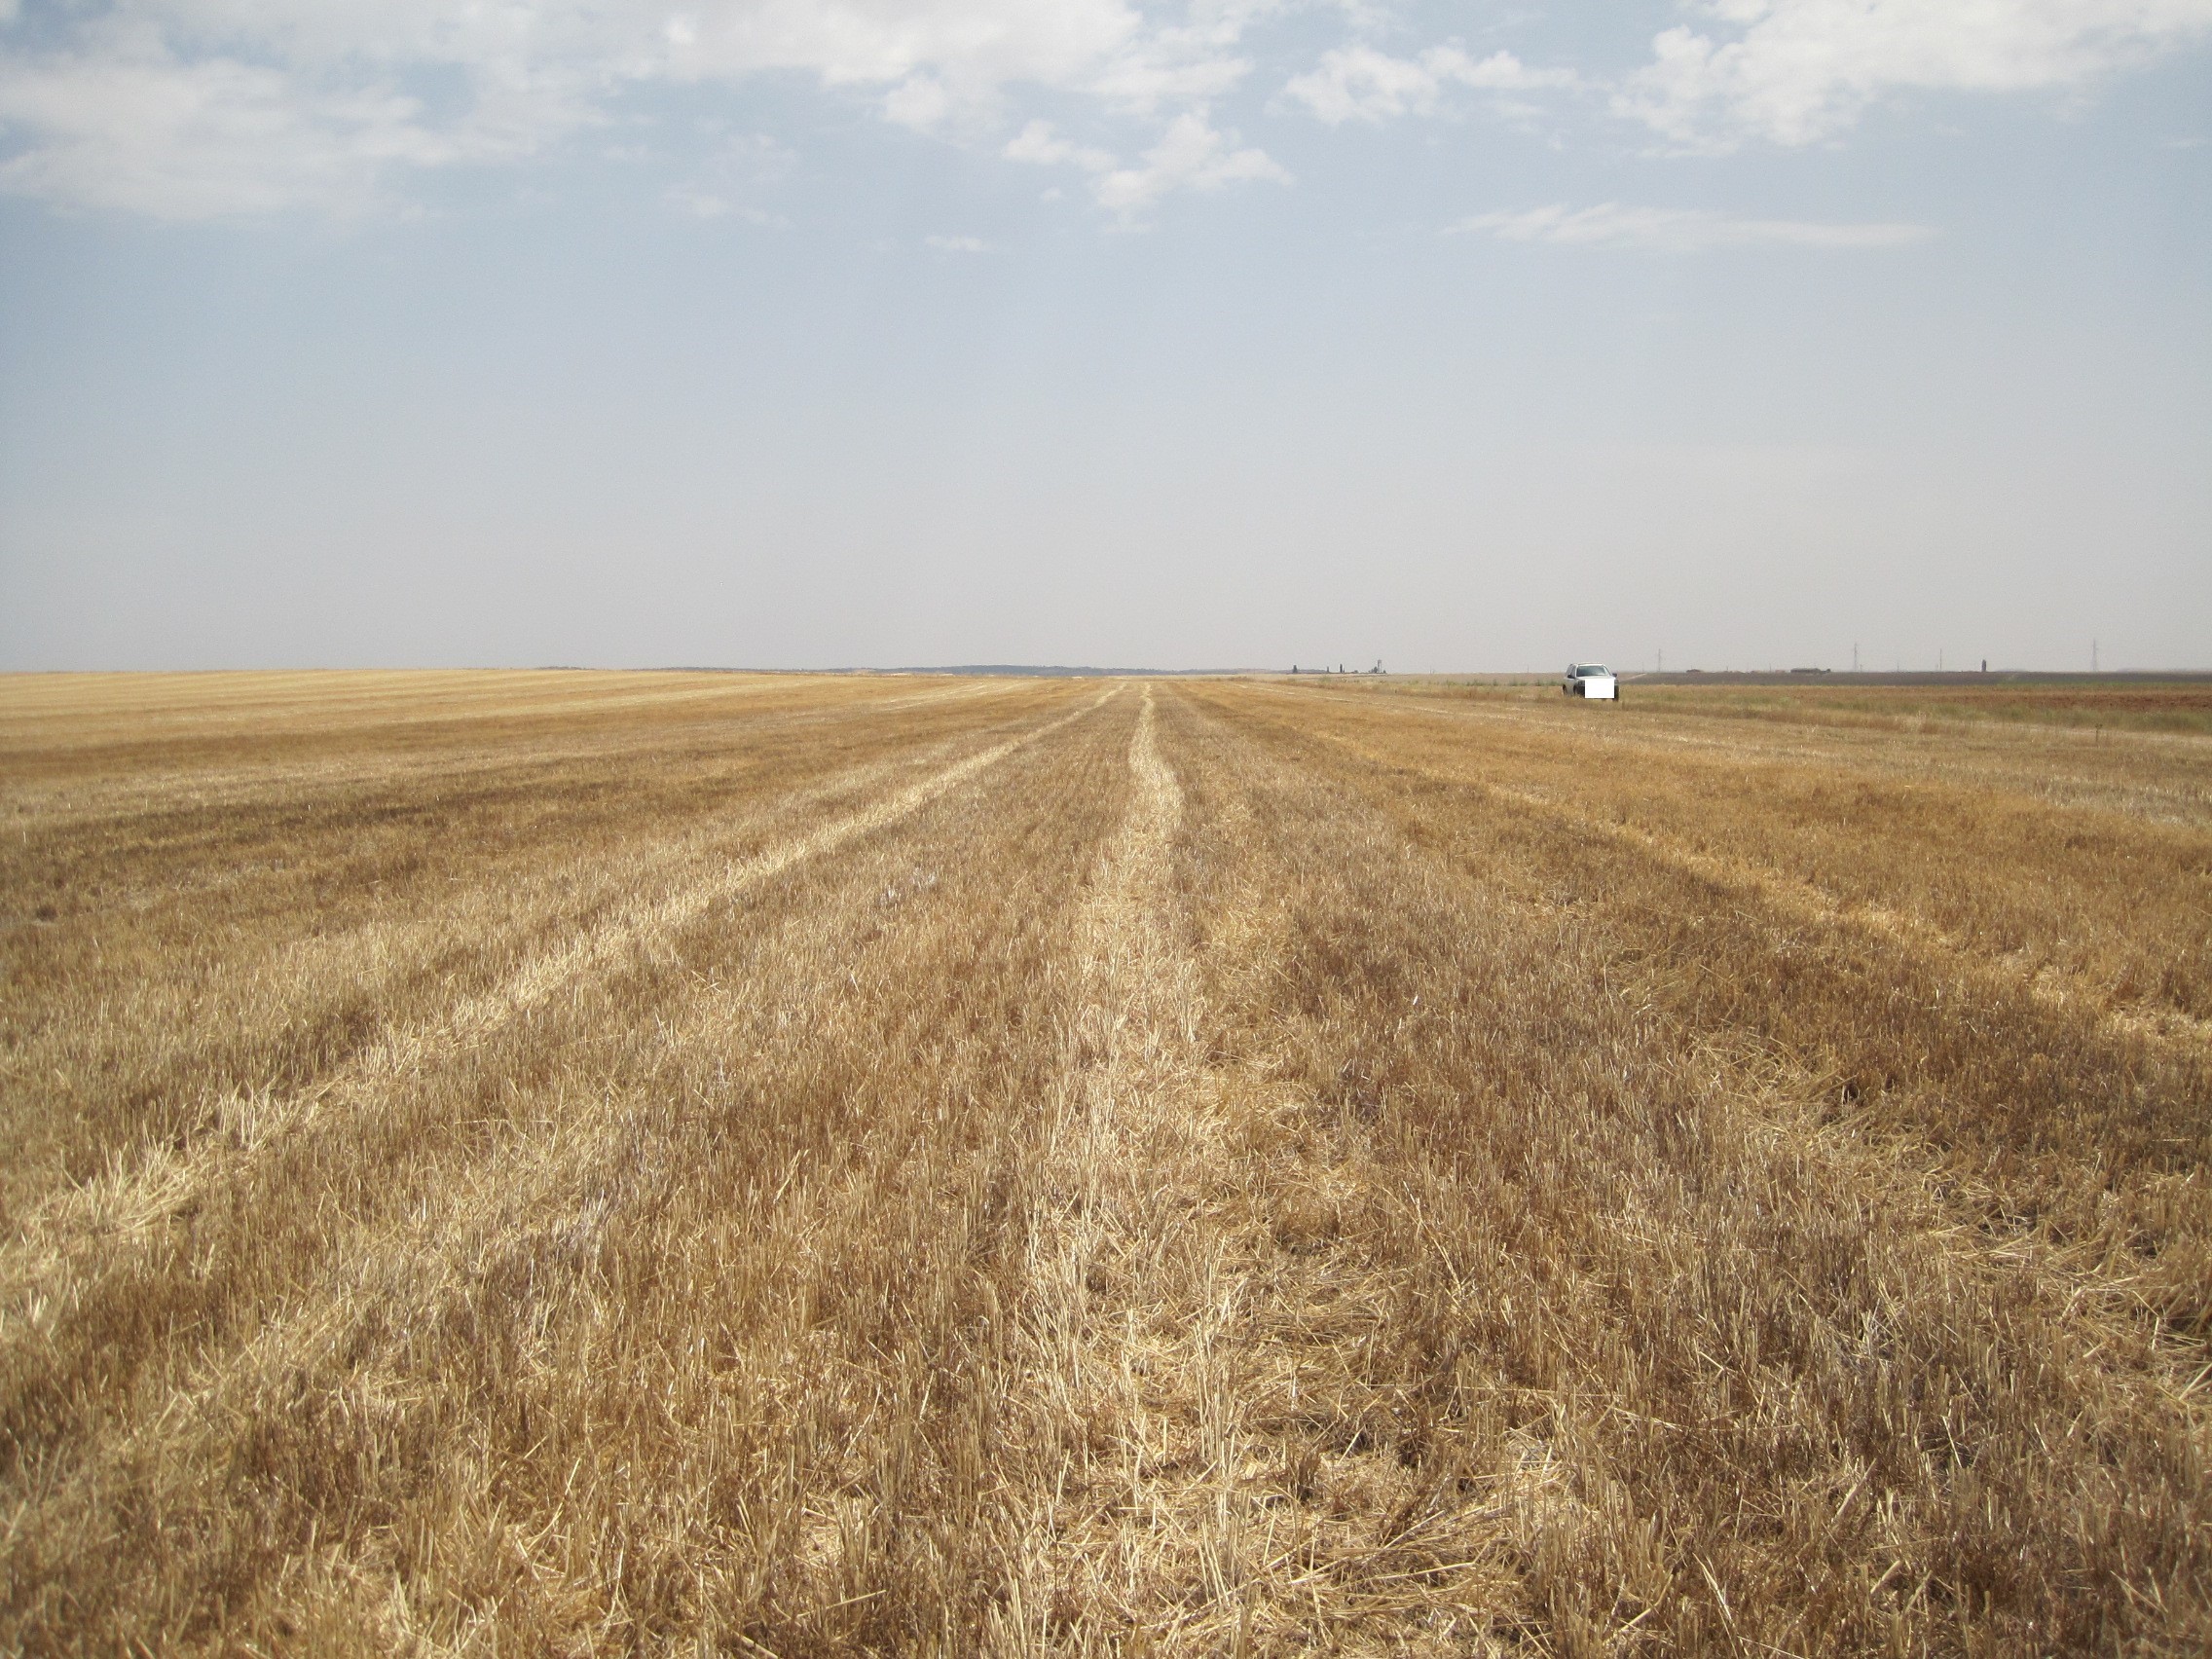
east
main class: Cropland
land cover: Common wheat
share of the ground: < 10 %
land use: Agriculture (excluding fallow land and kitchen gardens)
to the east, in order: Common wheat
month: July
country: ES
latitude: 41.7330
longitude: -5.5835
